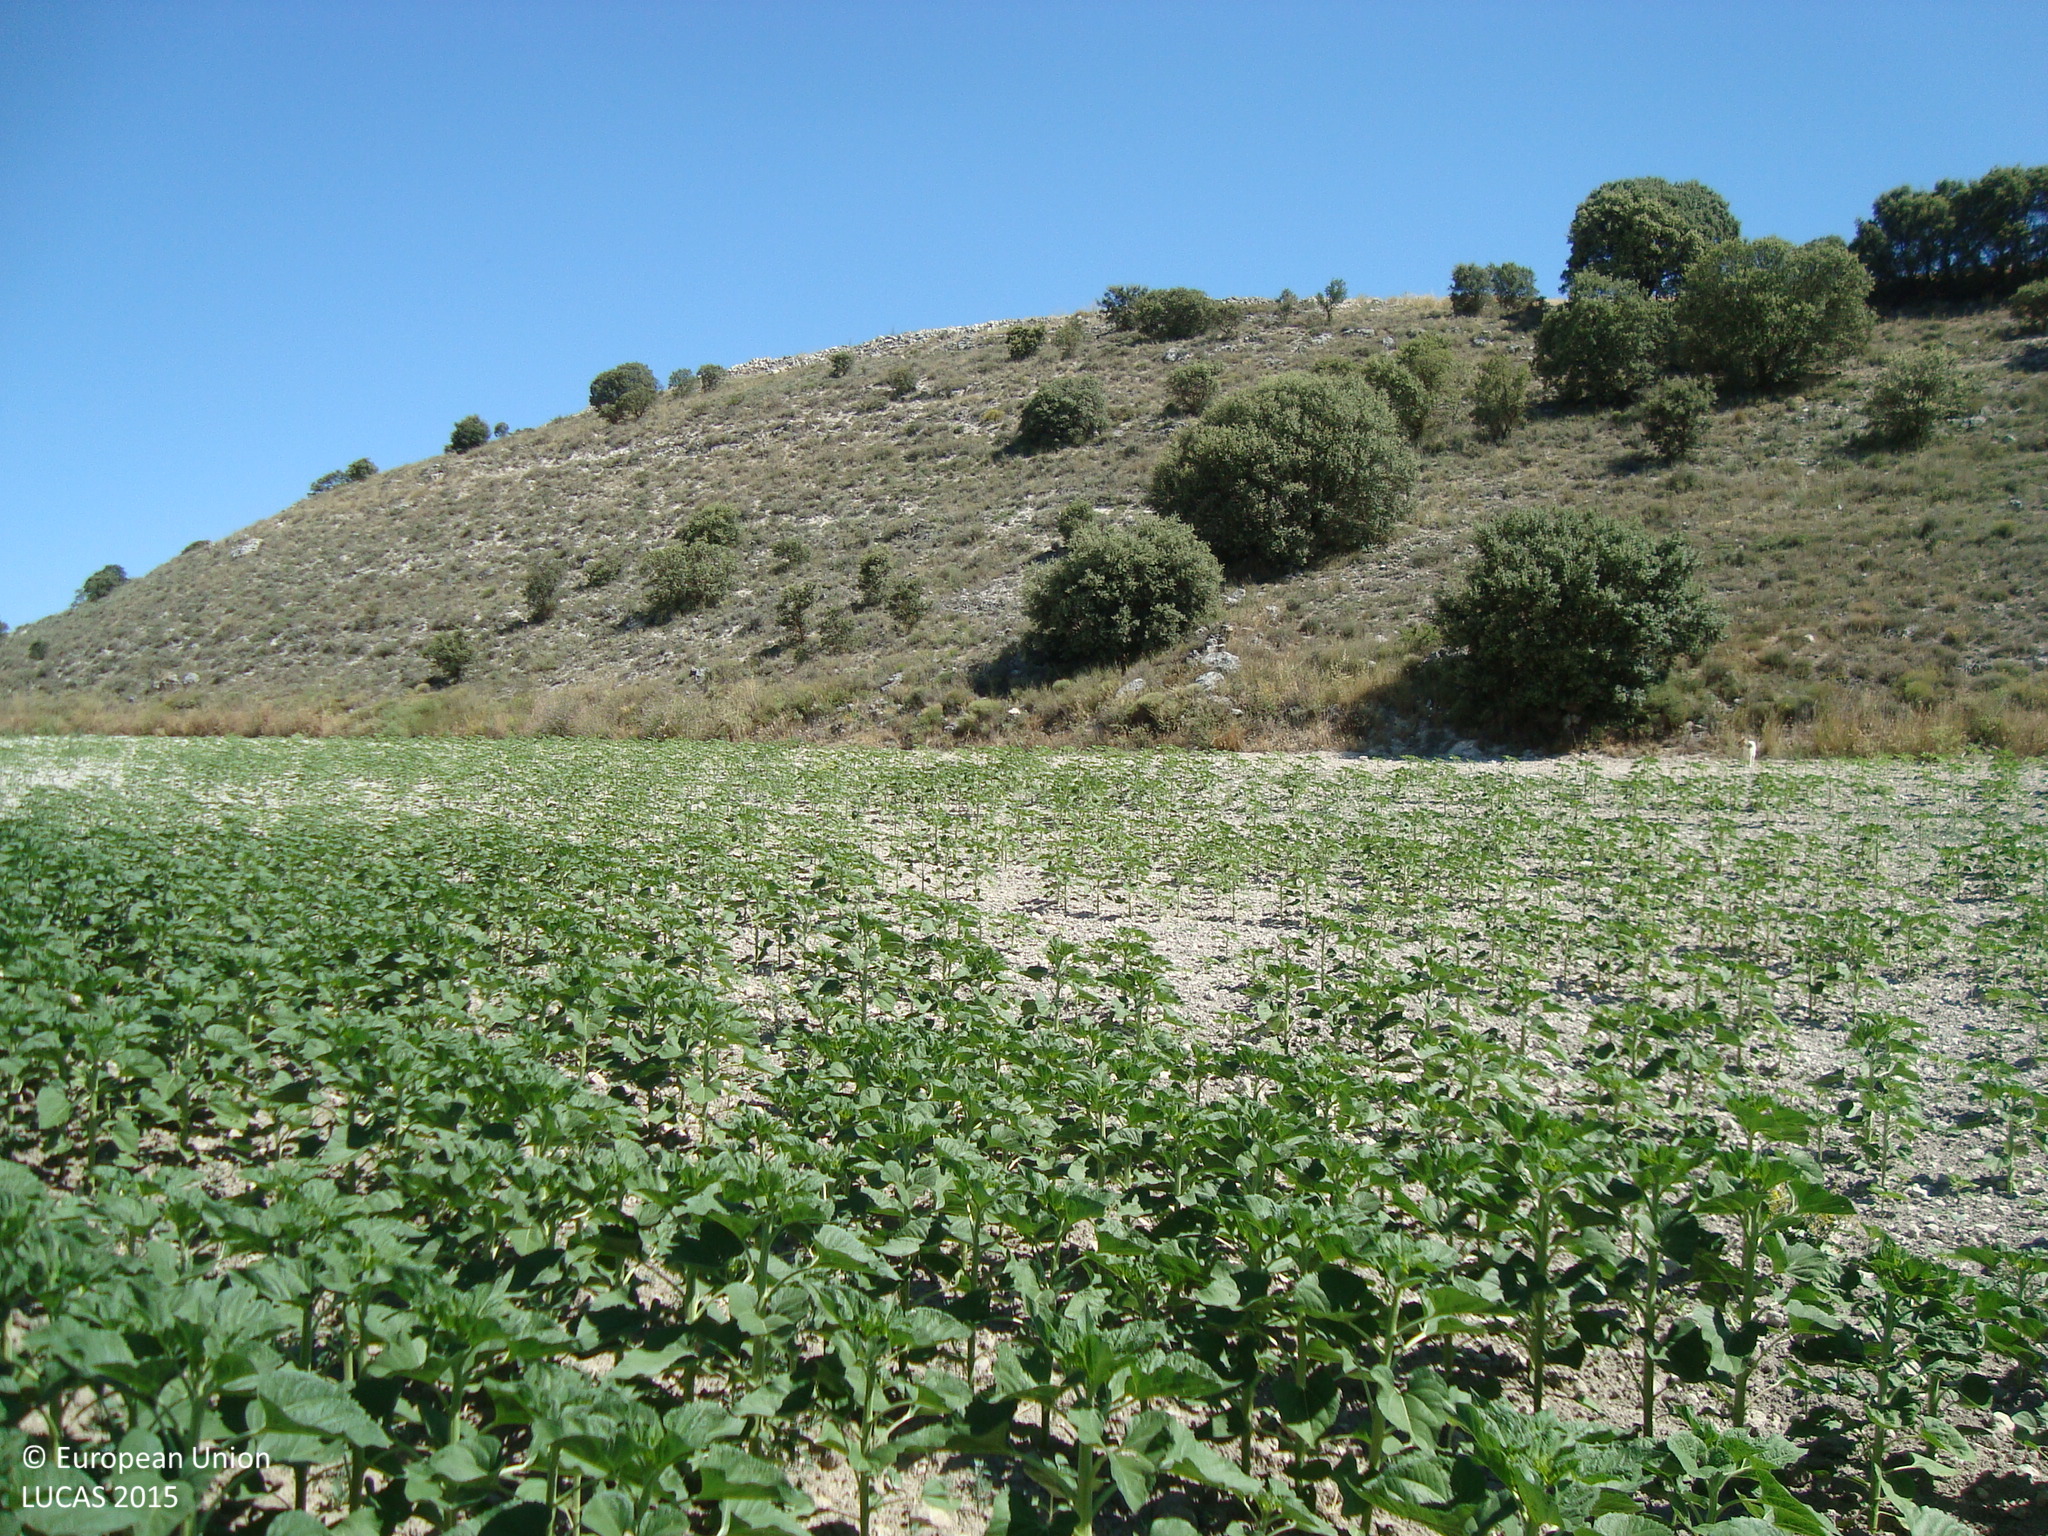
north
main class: Cropland
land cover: Sunflower
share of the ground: 50 - 75 %
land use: Agriculture (excluding fallow land and kitchen gardens)
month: July
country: ES
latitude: 41.6657
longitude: -4.0744
